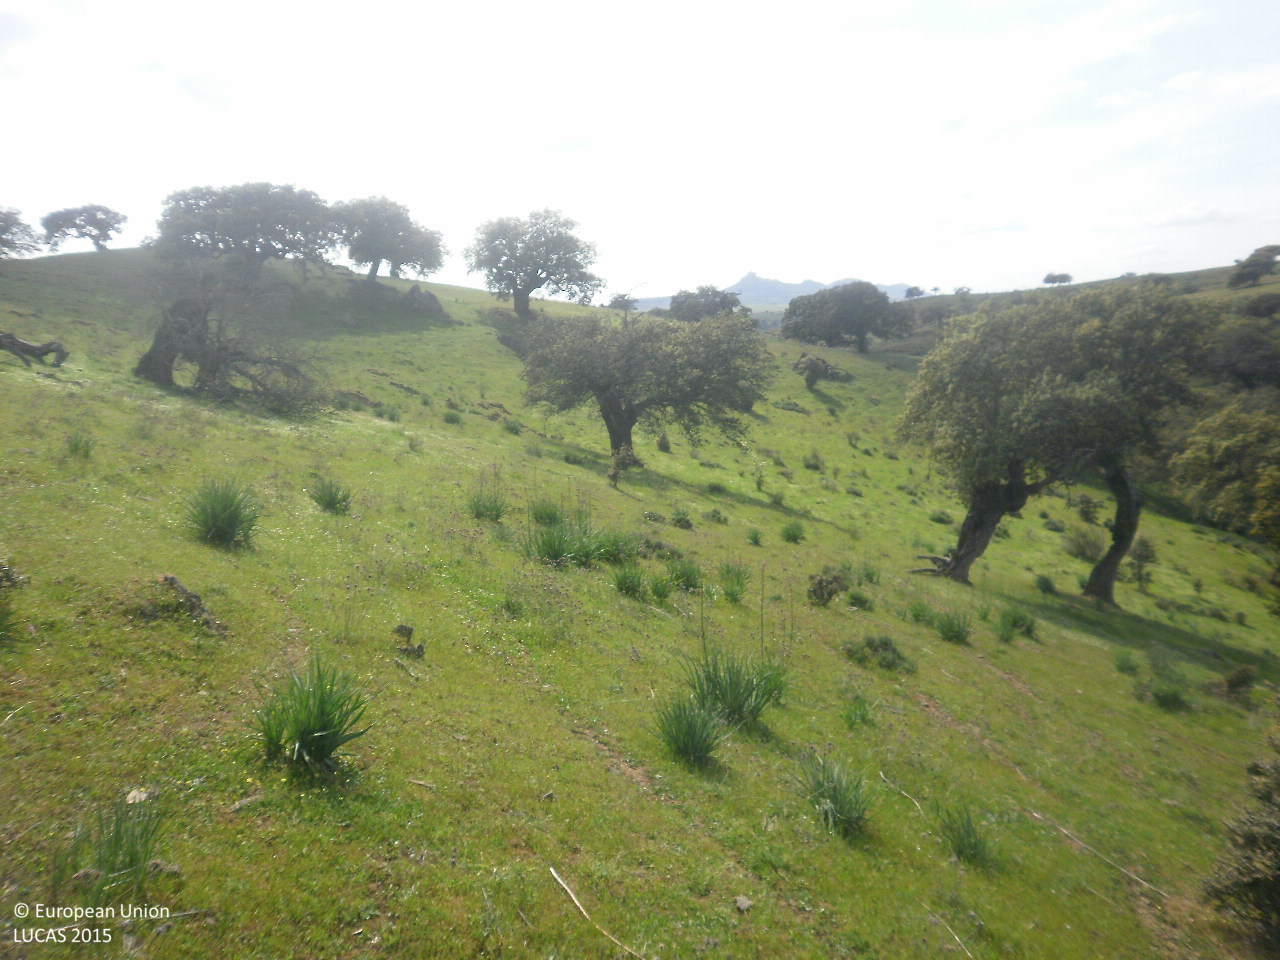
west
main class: Grassland
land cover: Grassland with sparse tree/shrub cover
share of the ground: > 75 %
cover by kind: herbaceous plants 85 %, shrubs 10 %, broadleaved forest trees 5 %
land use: Agriculture (excluding fallow land and kitchen gardens)
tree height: > 5 m
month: April
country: ES
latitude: 38.9876
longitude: -5.1733
